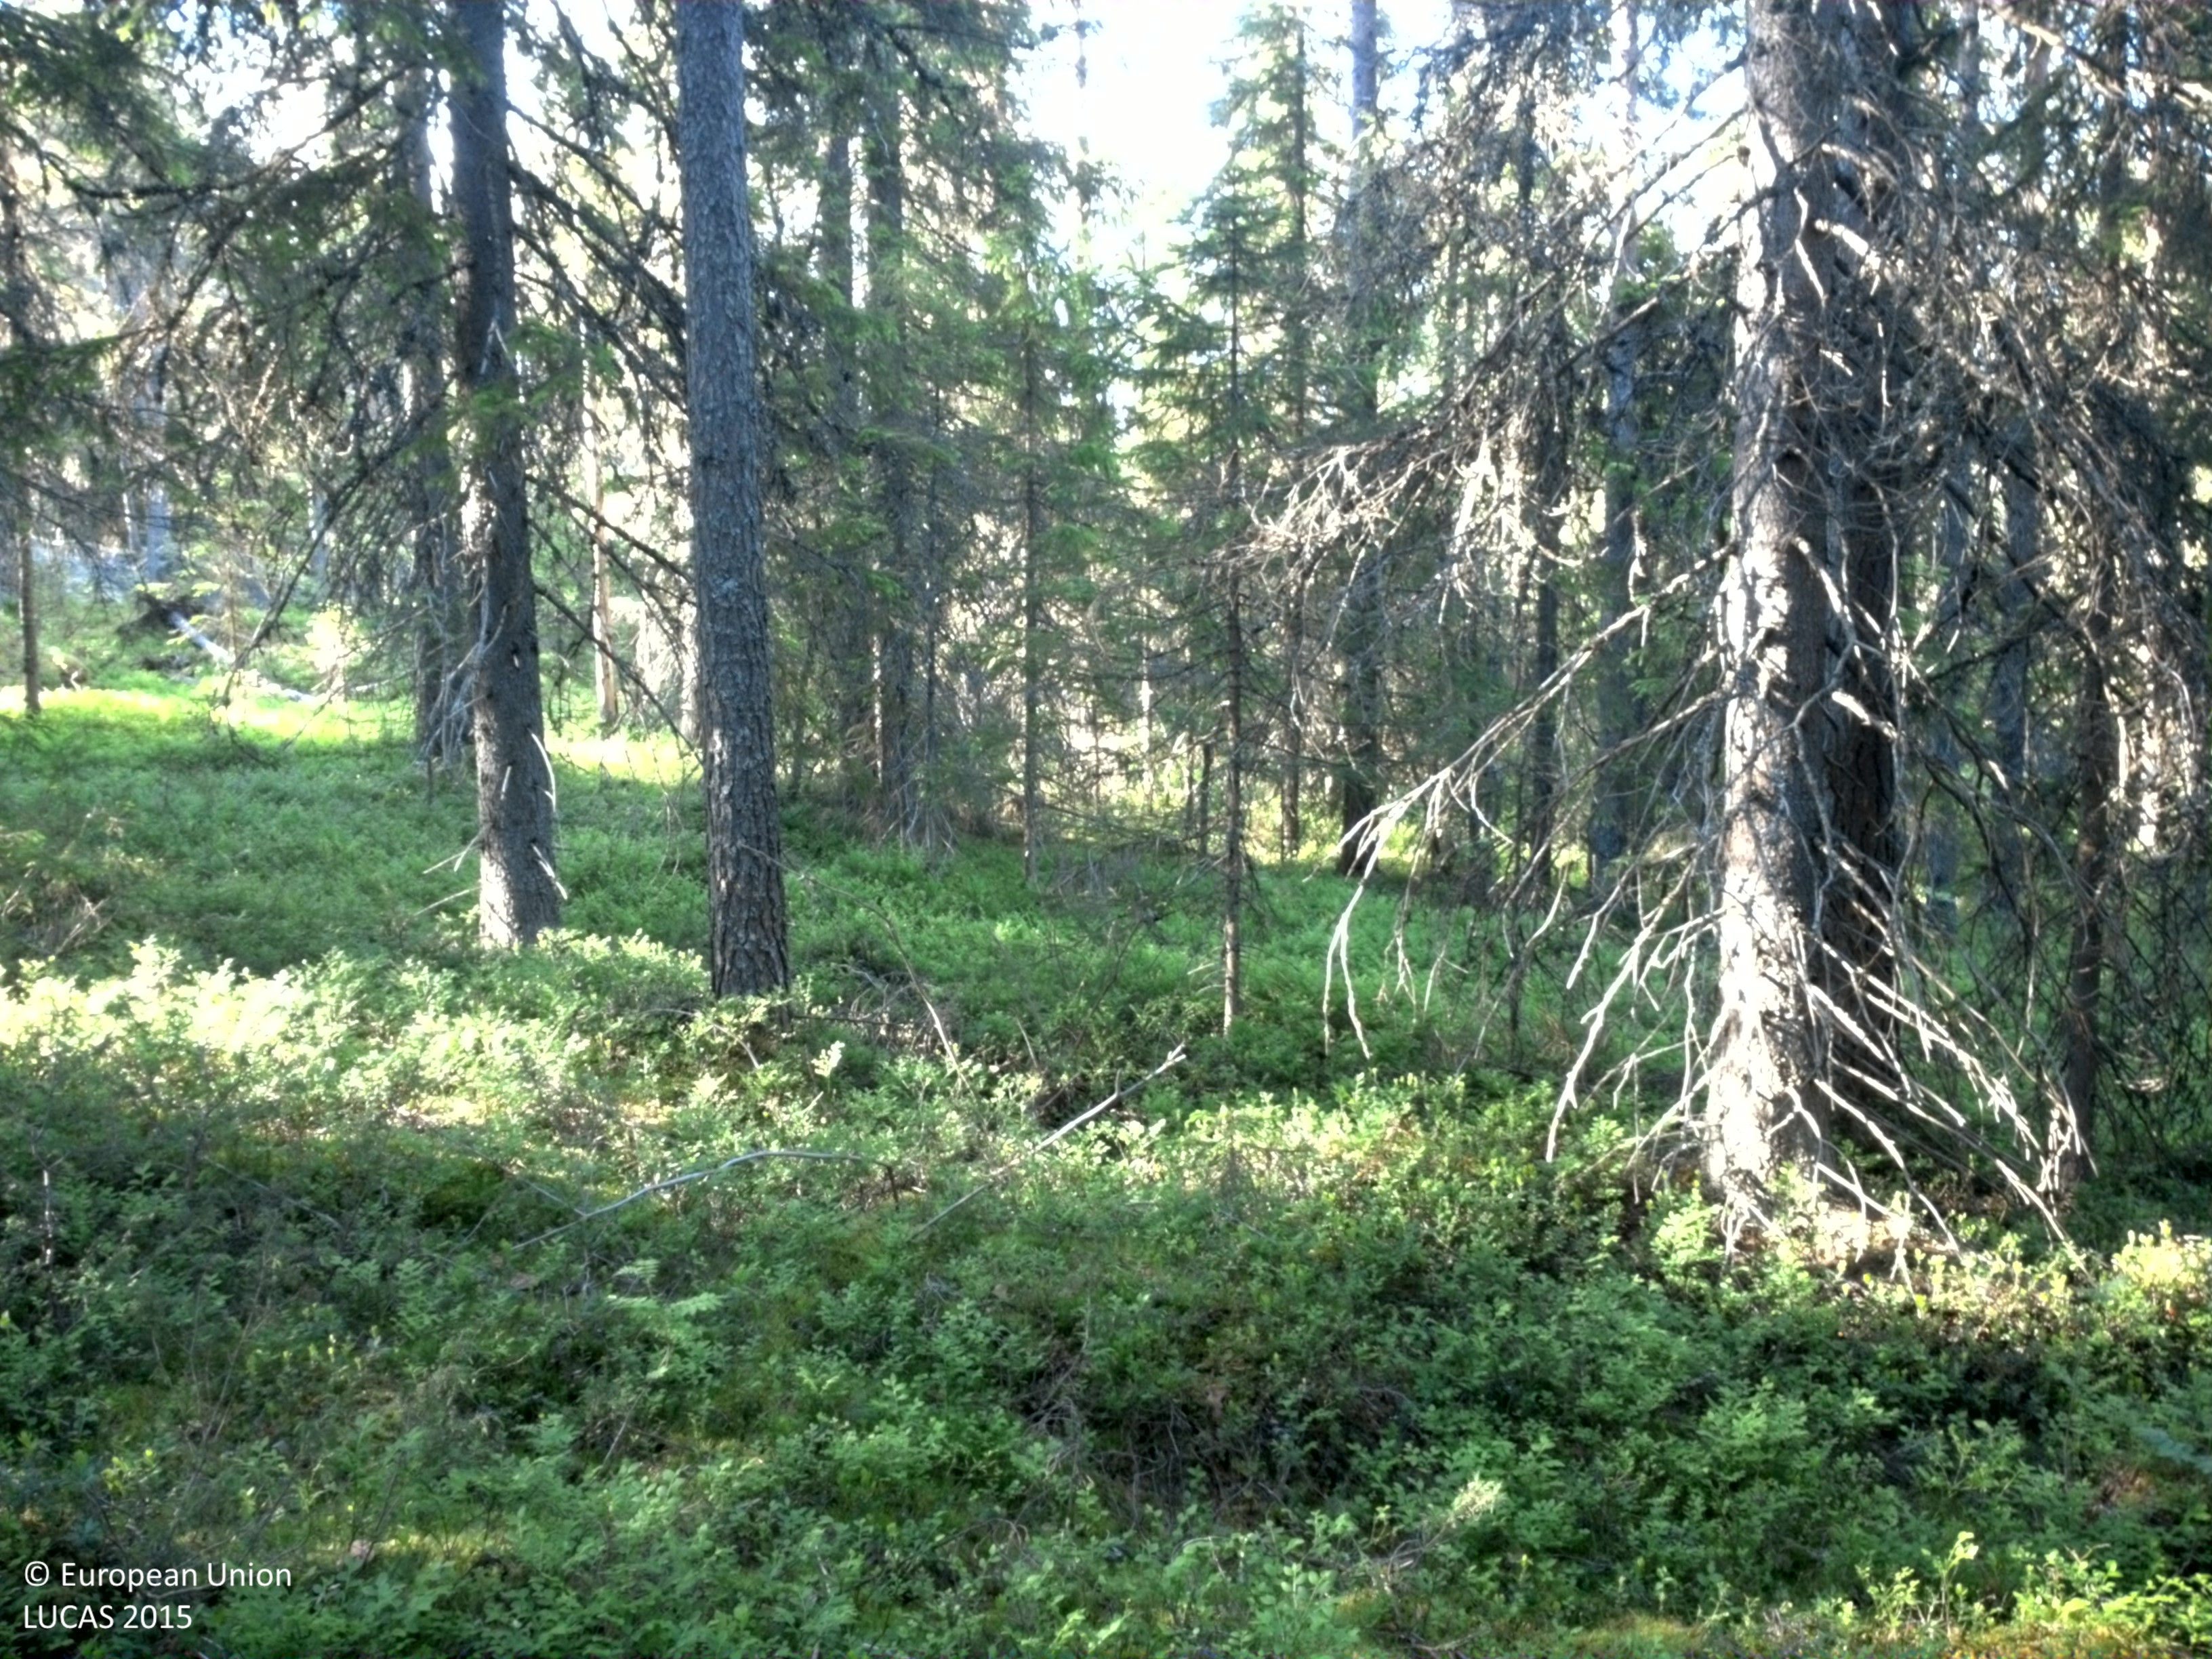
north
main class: Woodland
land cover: Spruce dominated coniferous woodland
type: boreal forest
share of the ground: 50 - 75 %
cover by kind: coniferous forest trees 75 %, shrubs 20 %, lichens and mosses 5 %
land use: Forestry
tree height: > 5 m
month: June
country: SE
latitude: 64.2404
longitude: 20.6428
